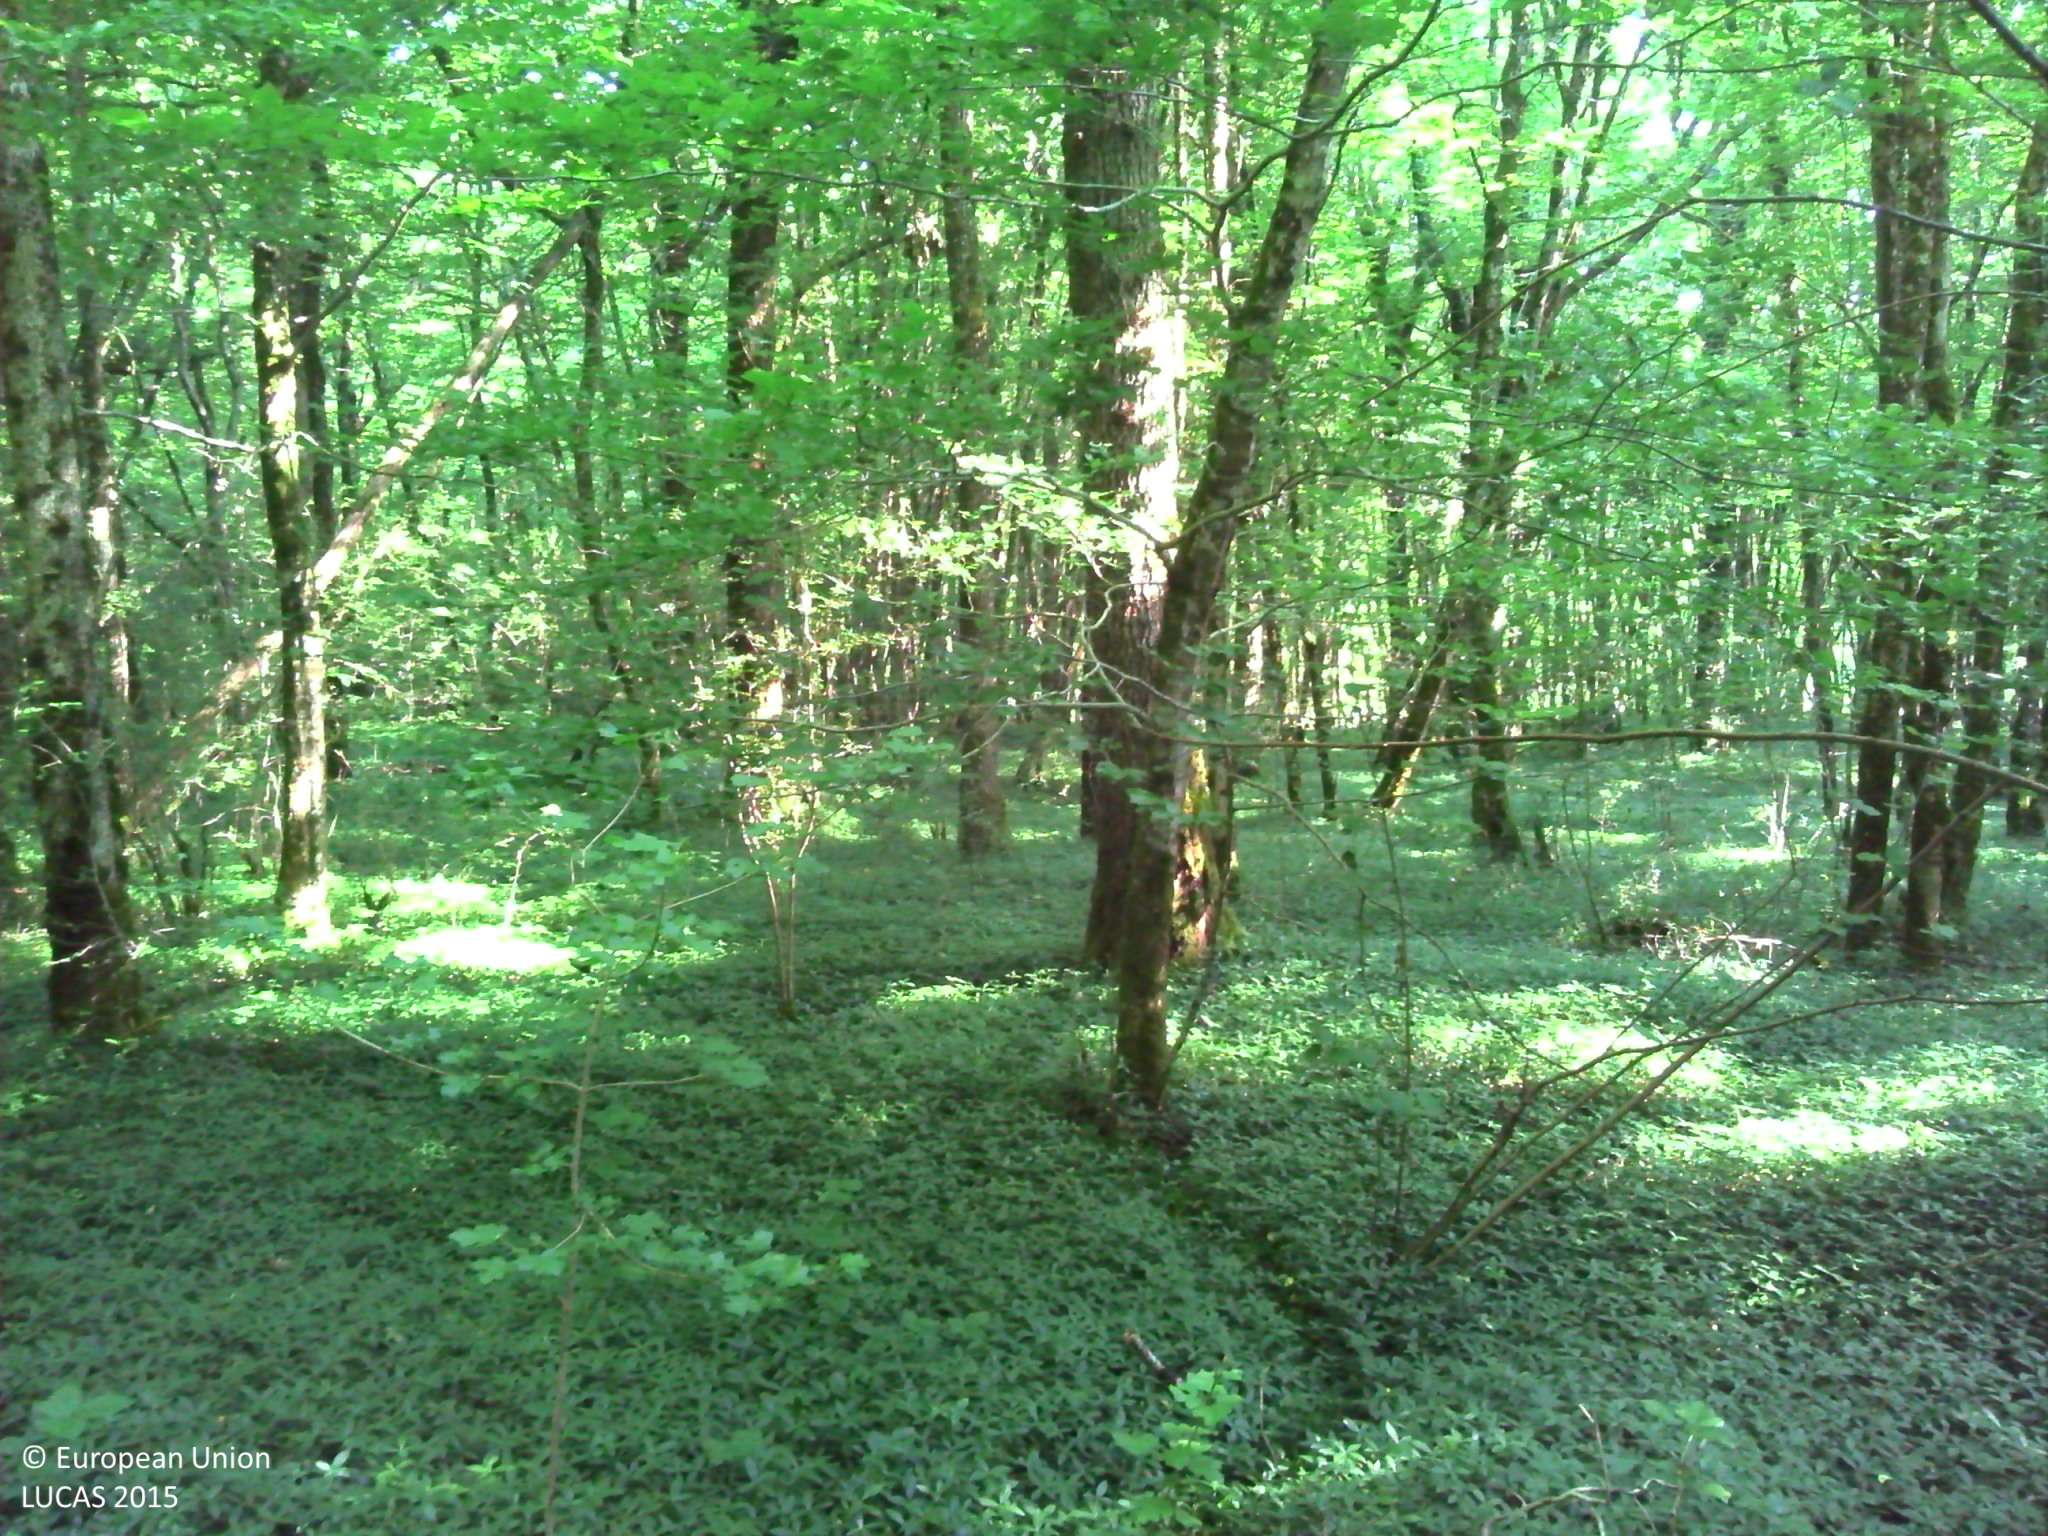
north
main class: Woodland
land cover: Broadleaved woodland
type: mesophytic deciduous forest
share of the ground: > 75 %
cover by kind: broadleaved forest trees 85 %, shrubs 10 %, herbaceous plants 5 %
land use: Forestry
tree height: > 5 m
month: June
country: FR
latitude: 46.7206
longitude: 0.6546
